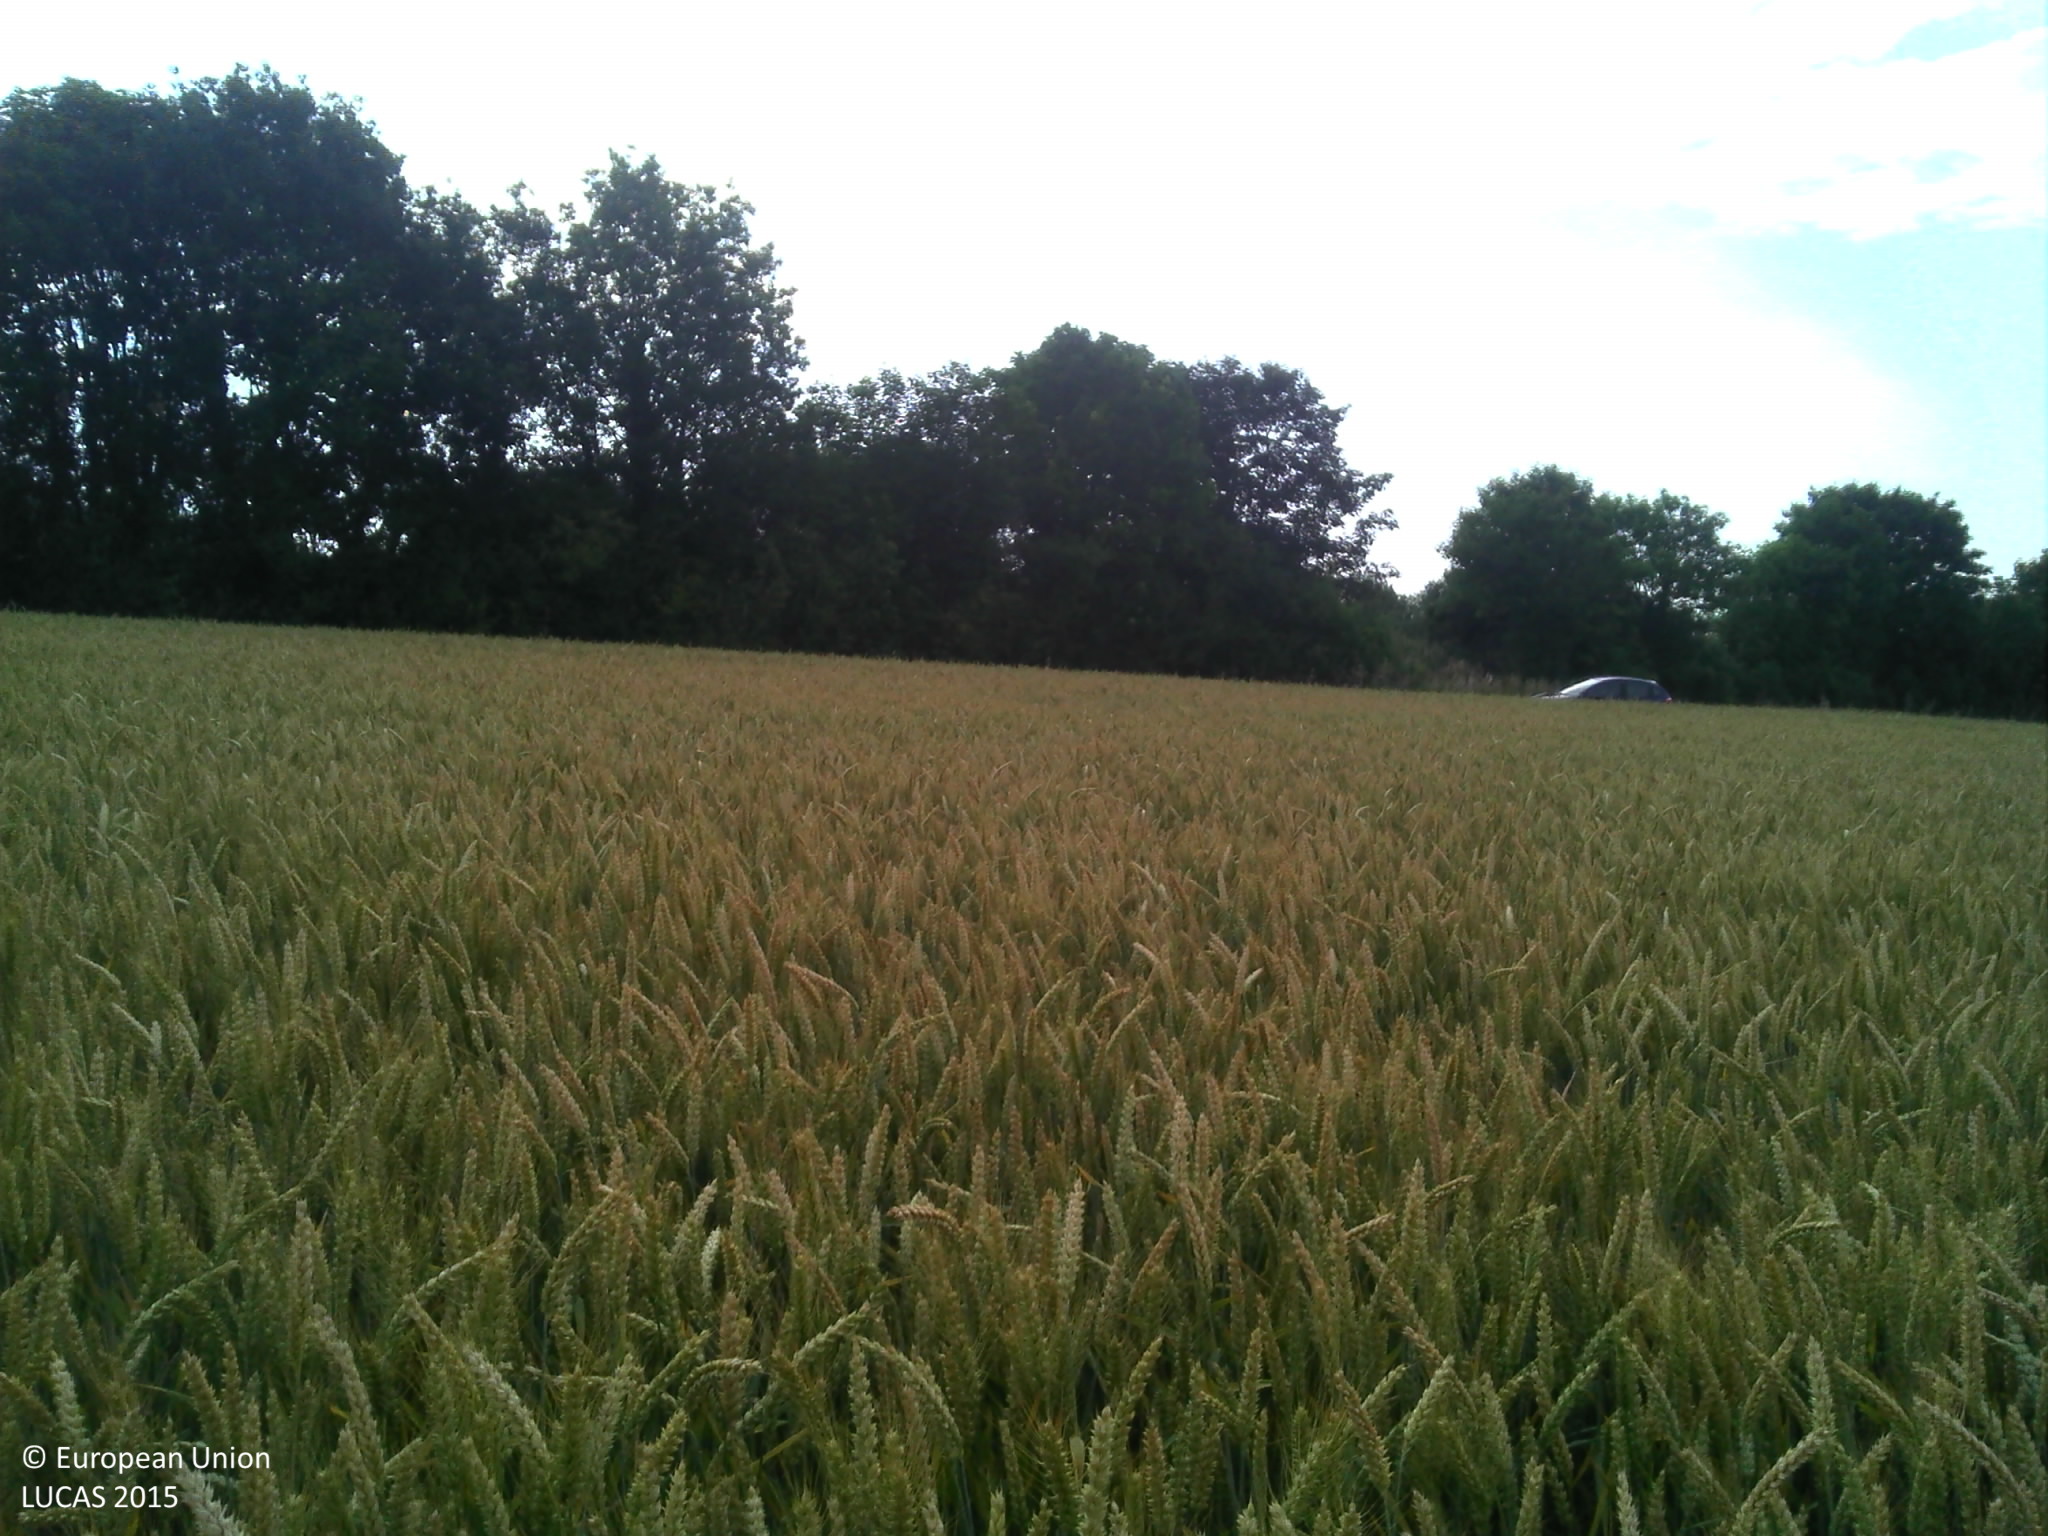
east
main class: Cropland
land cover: Common wheat
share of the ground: > 75 %
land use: Agriculture (excluding fallow land and kitchen gardens)
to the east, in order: Common wheat; Tracks; Broadleaved woodland; Grass margins; Lucerne; Grass margins; Grassland without tree/shrub cover; Dry pulses; Broadleaved woodland; Tracks; Broadleaved woodland; Rock outcrops
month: July
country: FR
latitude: 49.7229
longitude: 2.5391
